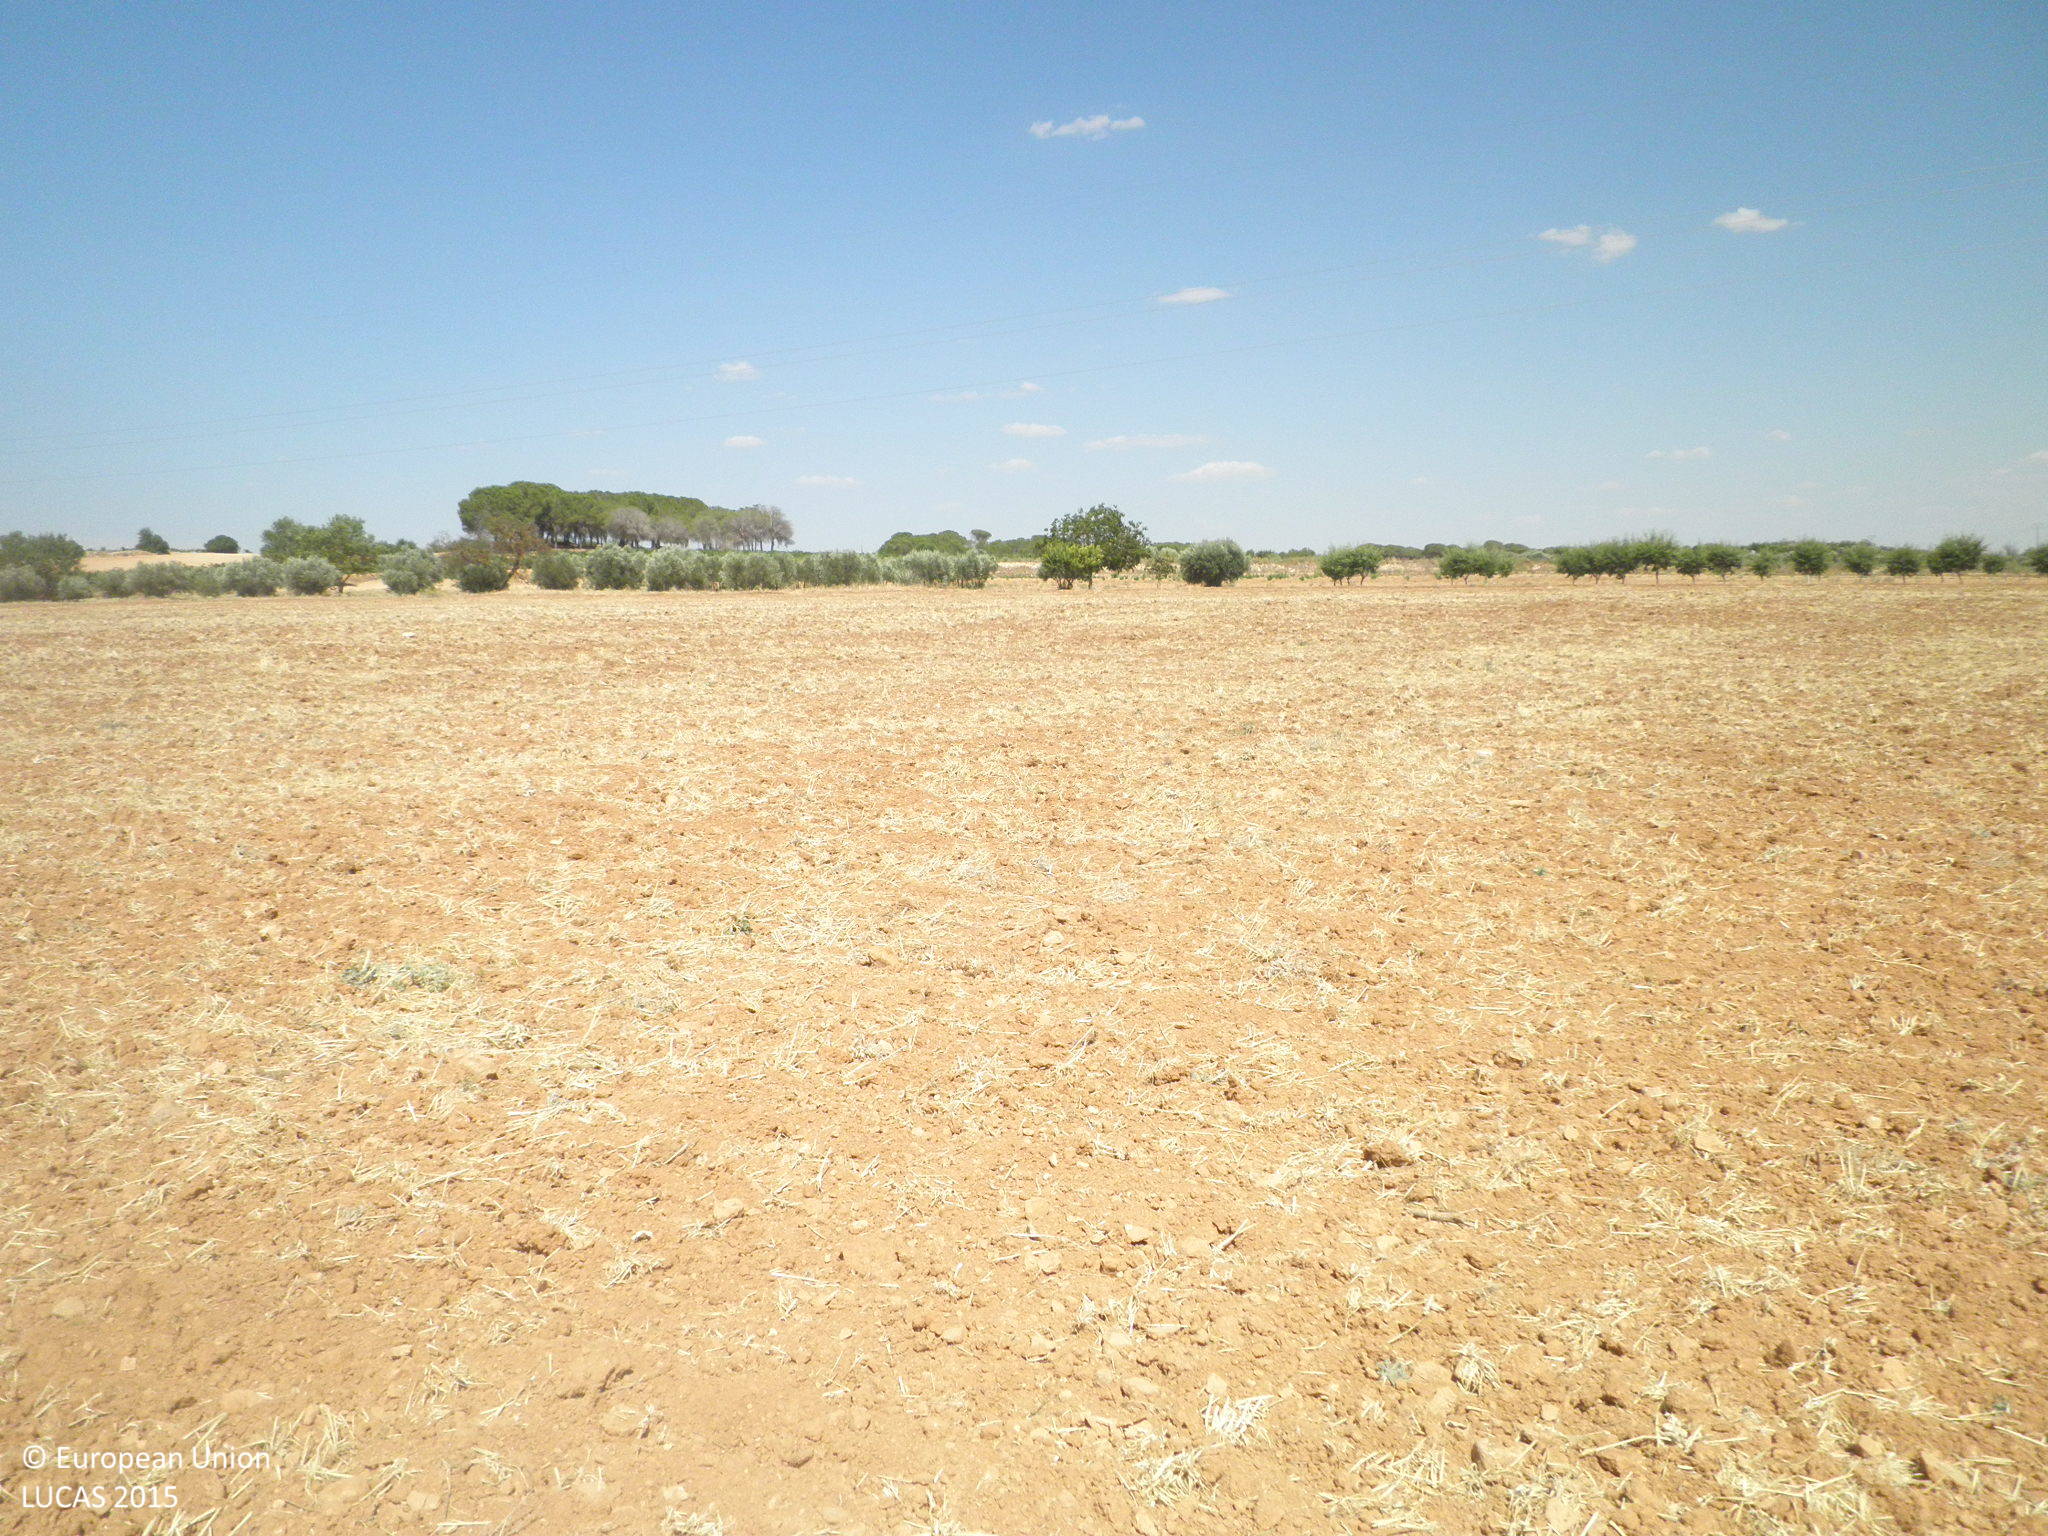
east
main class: Cropland
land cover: Barley
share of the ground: < 10 %
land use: Agriculture (excluding fallow land and kitchen gardens)
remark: Harvested field
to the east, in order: Barley; Olive groves; Electric lines; Olive groves; Spontaneously vegetated surfaces; Vineyards; Spontaneously vegetated surfaces; Grass margins; Tracks; Grass margins; Dry stone walls; Paved roads, cycling and walking lanes; Grass margins; Dry stone walls; Grass margins; Nuts trees
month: July
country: ES
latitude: 39.2877
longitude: -1.7244
